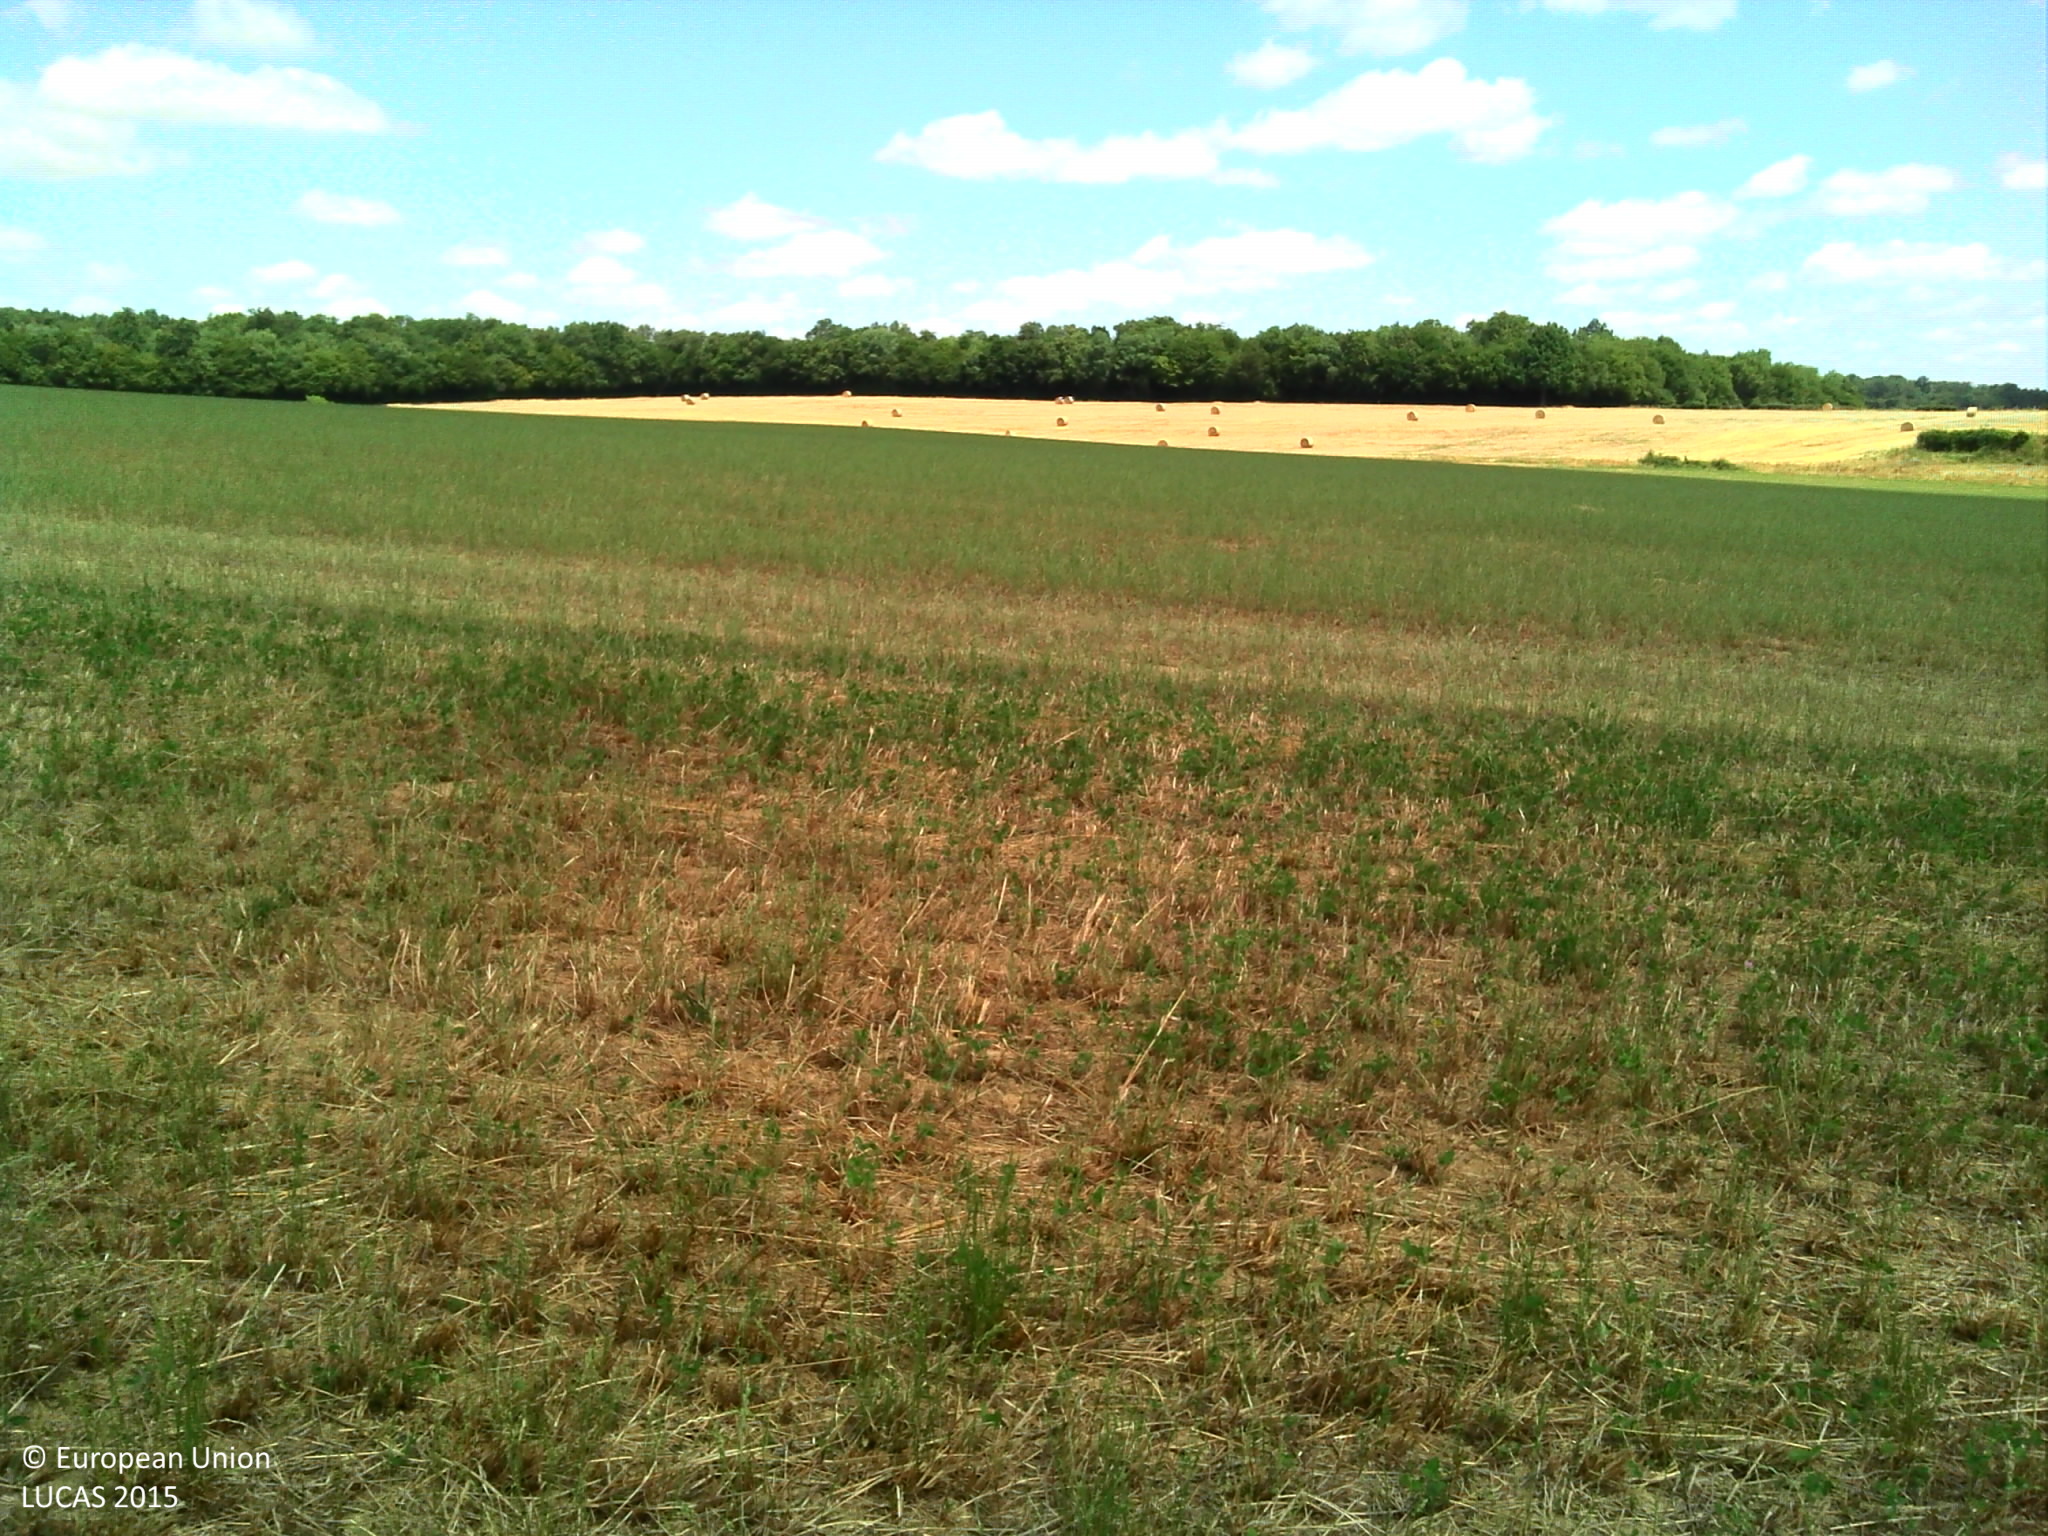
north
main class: Cropland
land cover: Mixed cereals for fodder
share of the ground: > 75 %
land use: Agriculture (excluding fallow land and kitchen gardens)
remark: Harvested field
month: July
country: FR
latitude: 46.9019
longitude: 3.6315
